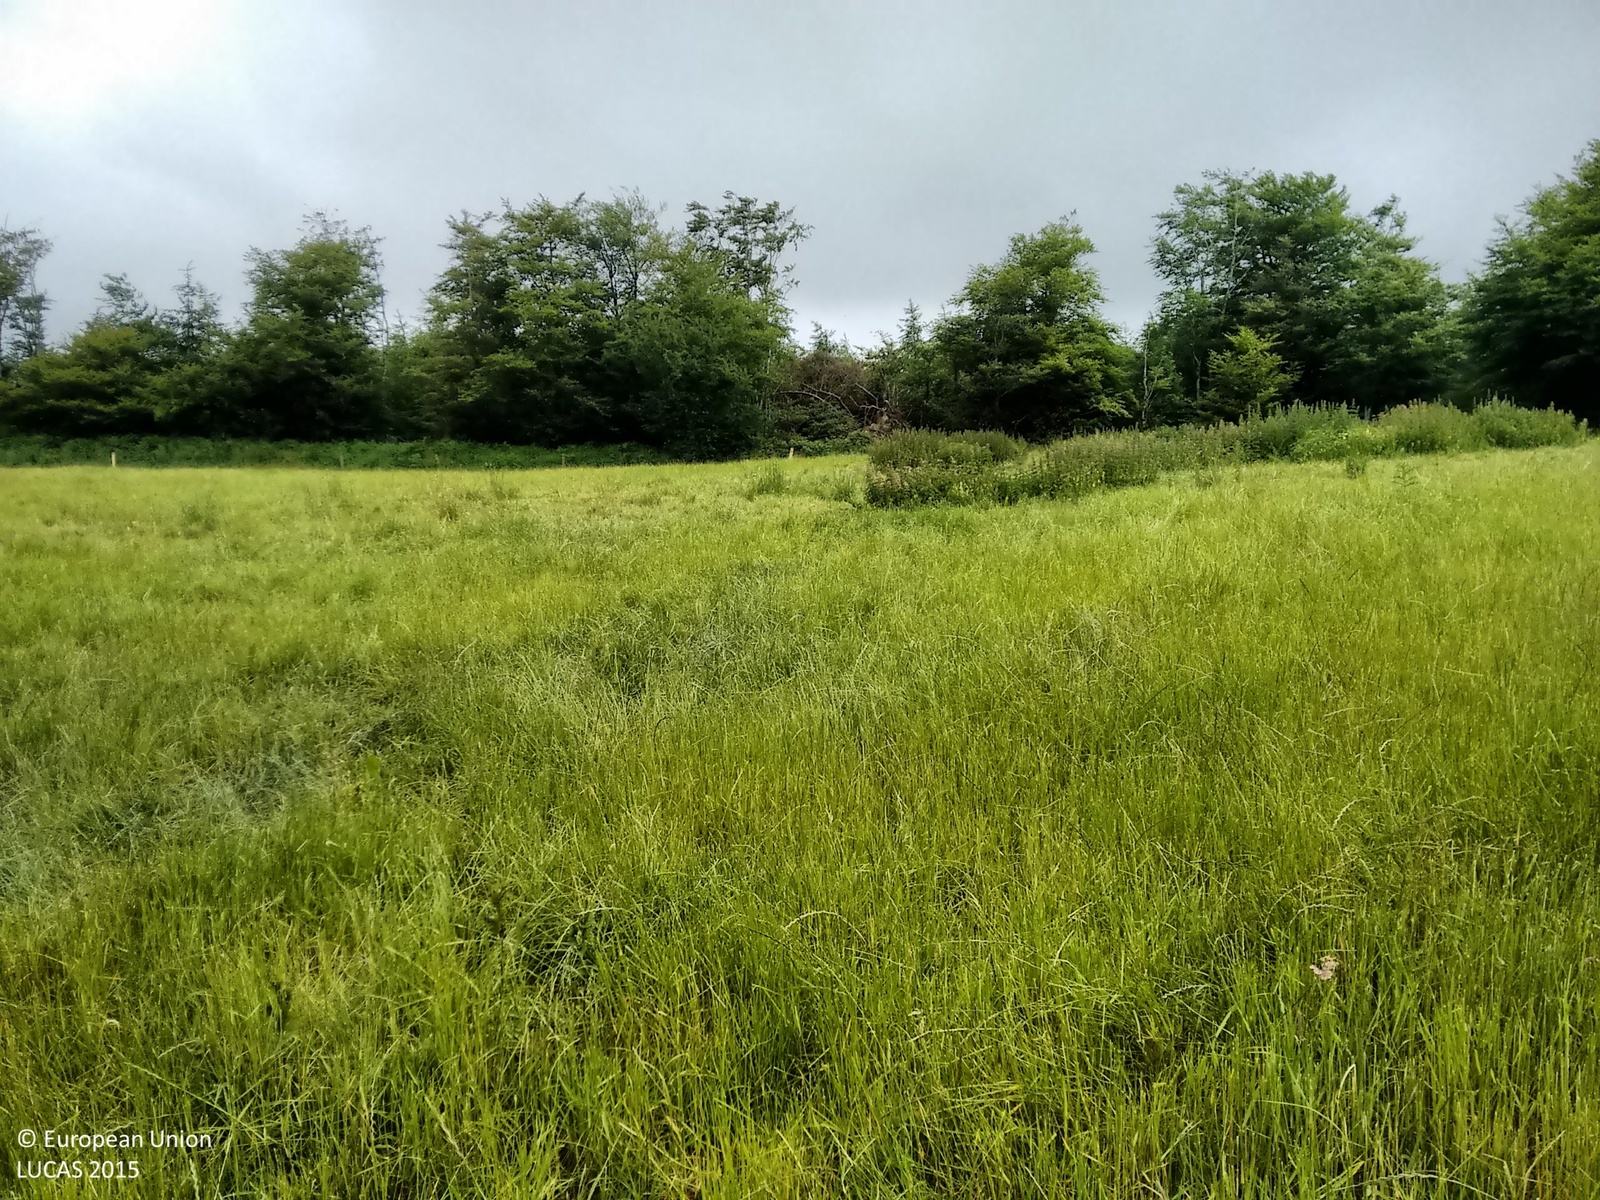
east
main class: Grassland
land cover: Grassland without tree/shrub cover
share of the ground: > 75 %
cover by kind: herbaceous plants 100 %
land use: Agriculture (excluding fallow land and kitchen gardens)
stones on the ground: < 10 %
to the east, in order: Grassland without tree/shrub cover; Fences; Broadleaved woodland; Pine dominated coniferous woodland
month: June
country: IE
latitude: 52.4607
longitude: -7.3897
